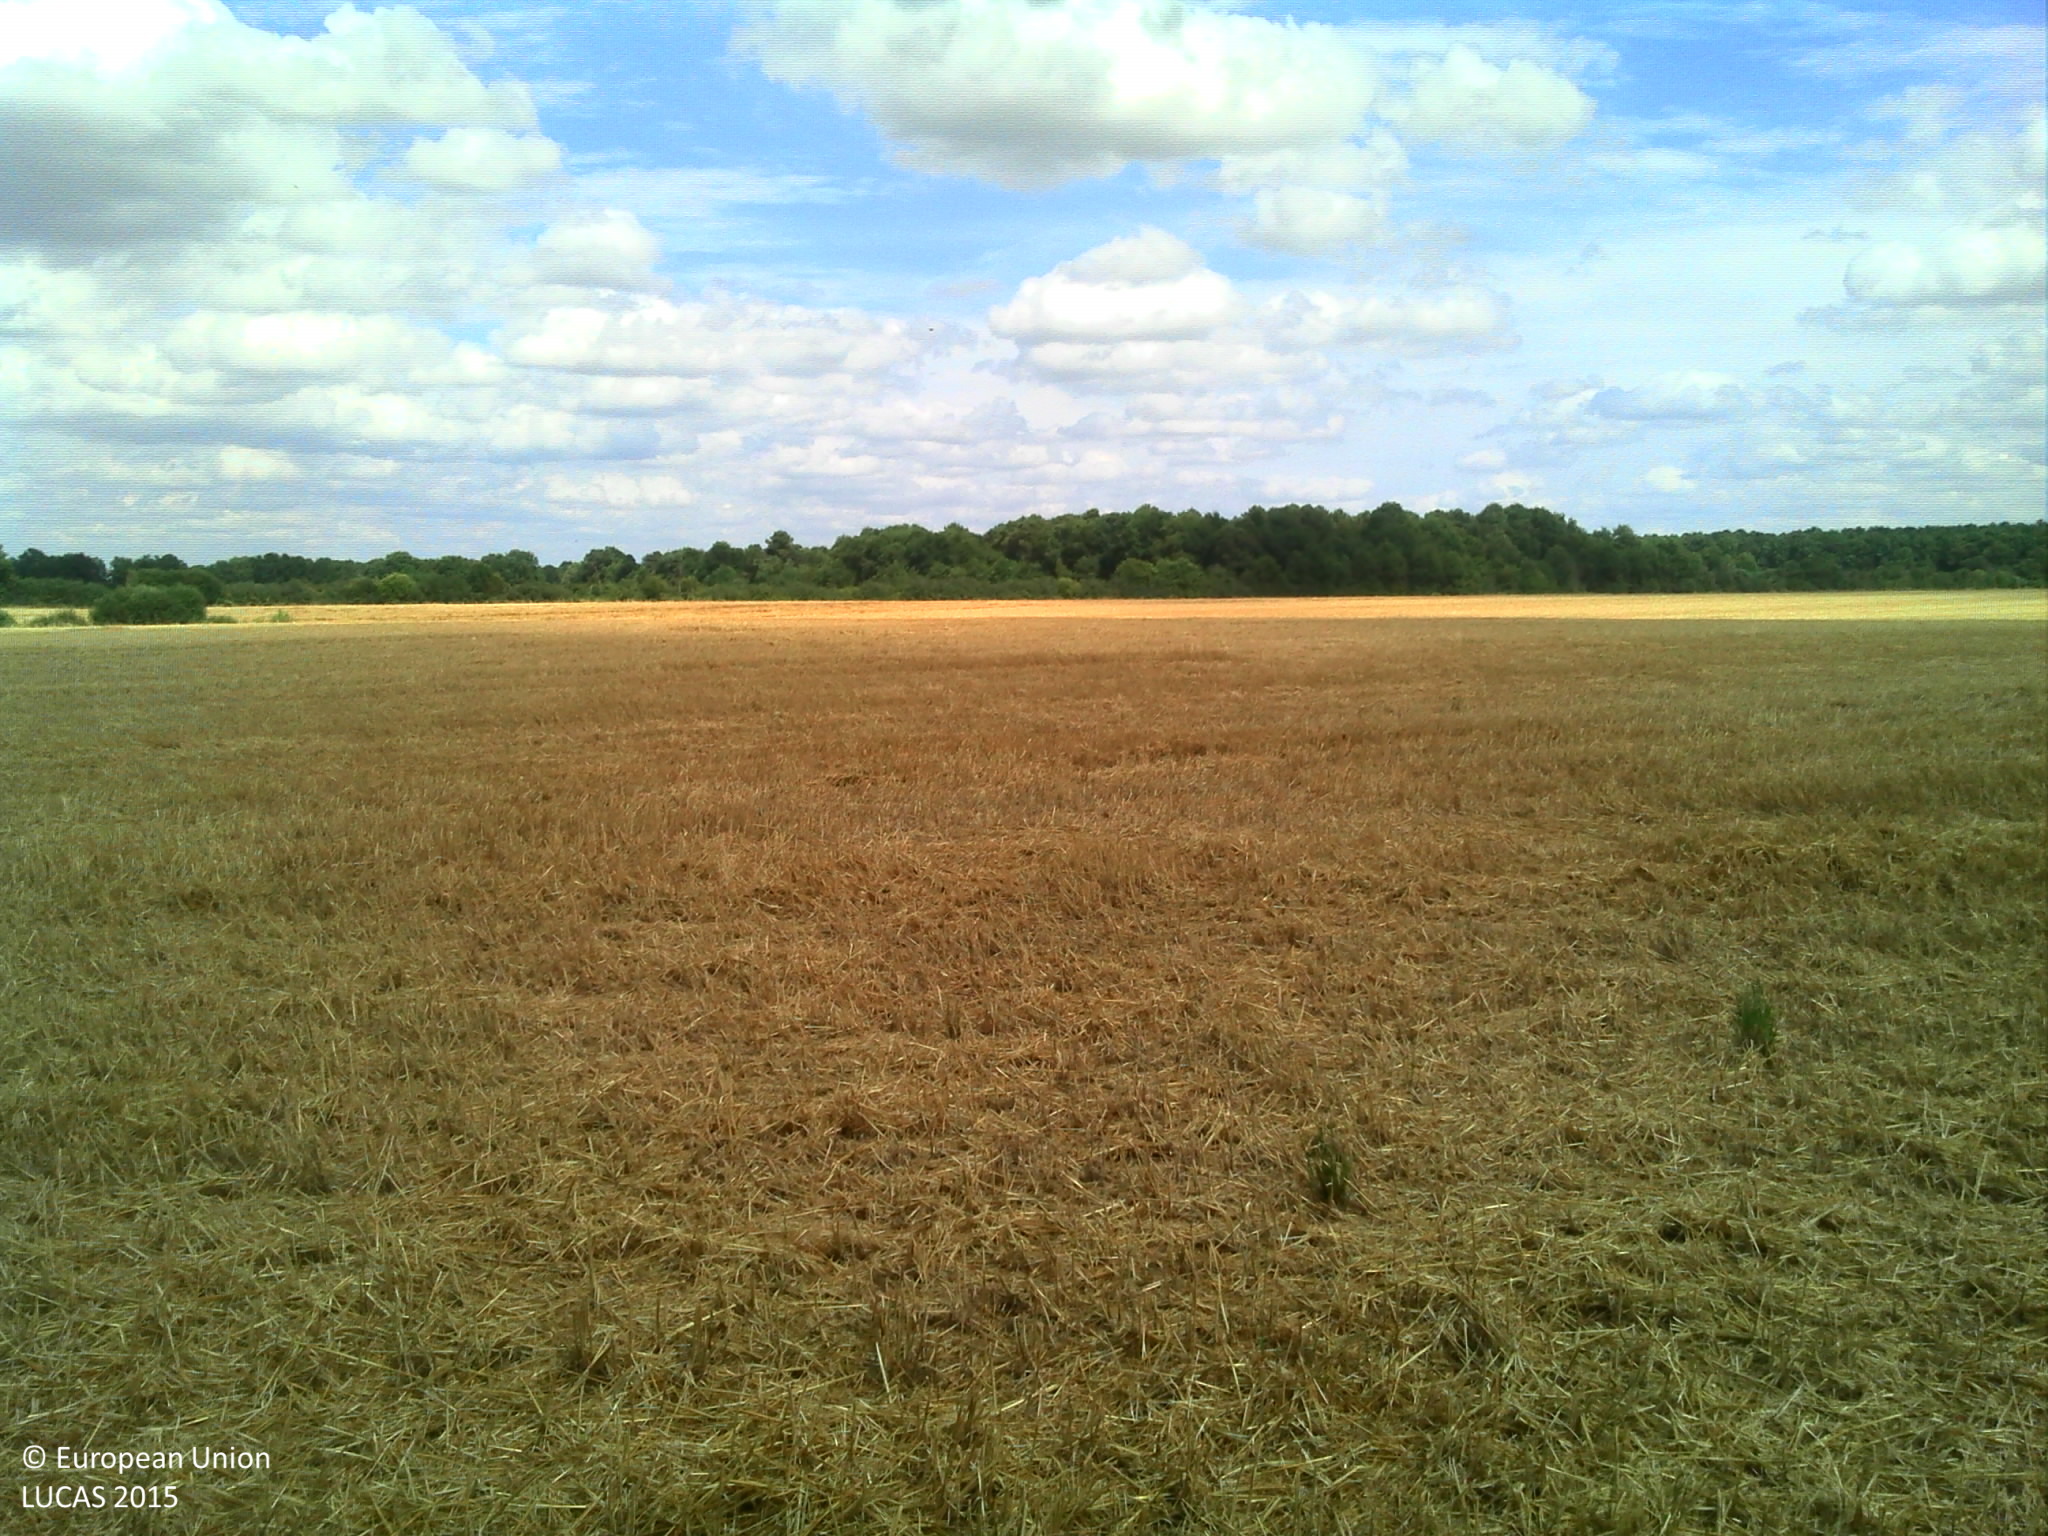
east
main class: Cropland
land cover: Common wheat
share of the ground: > 75 %
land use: Agriculture (excluding fallow land and kitchen gardens)
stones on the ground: < 10 %
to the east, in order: Common wheat
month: July
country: FR
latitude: 47.1156
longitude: 0.8229
